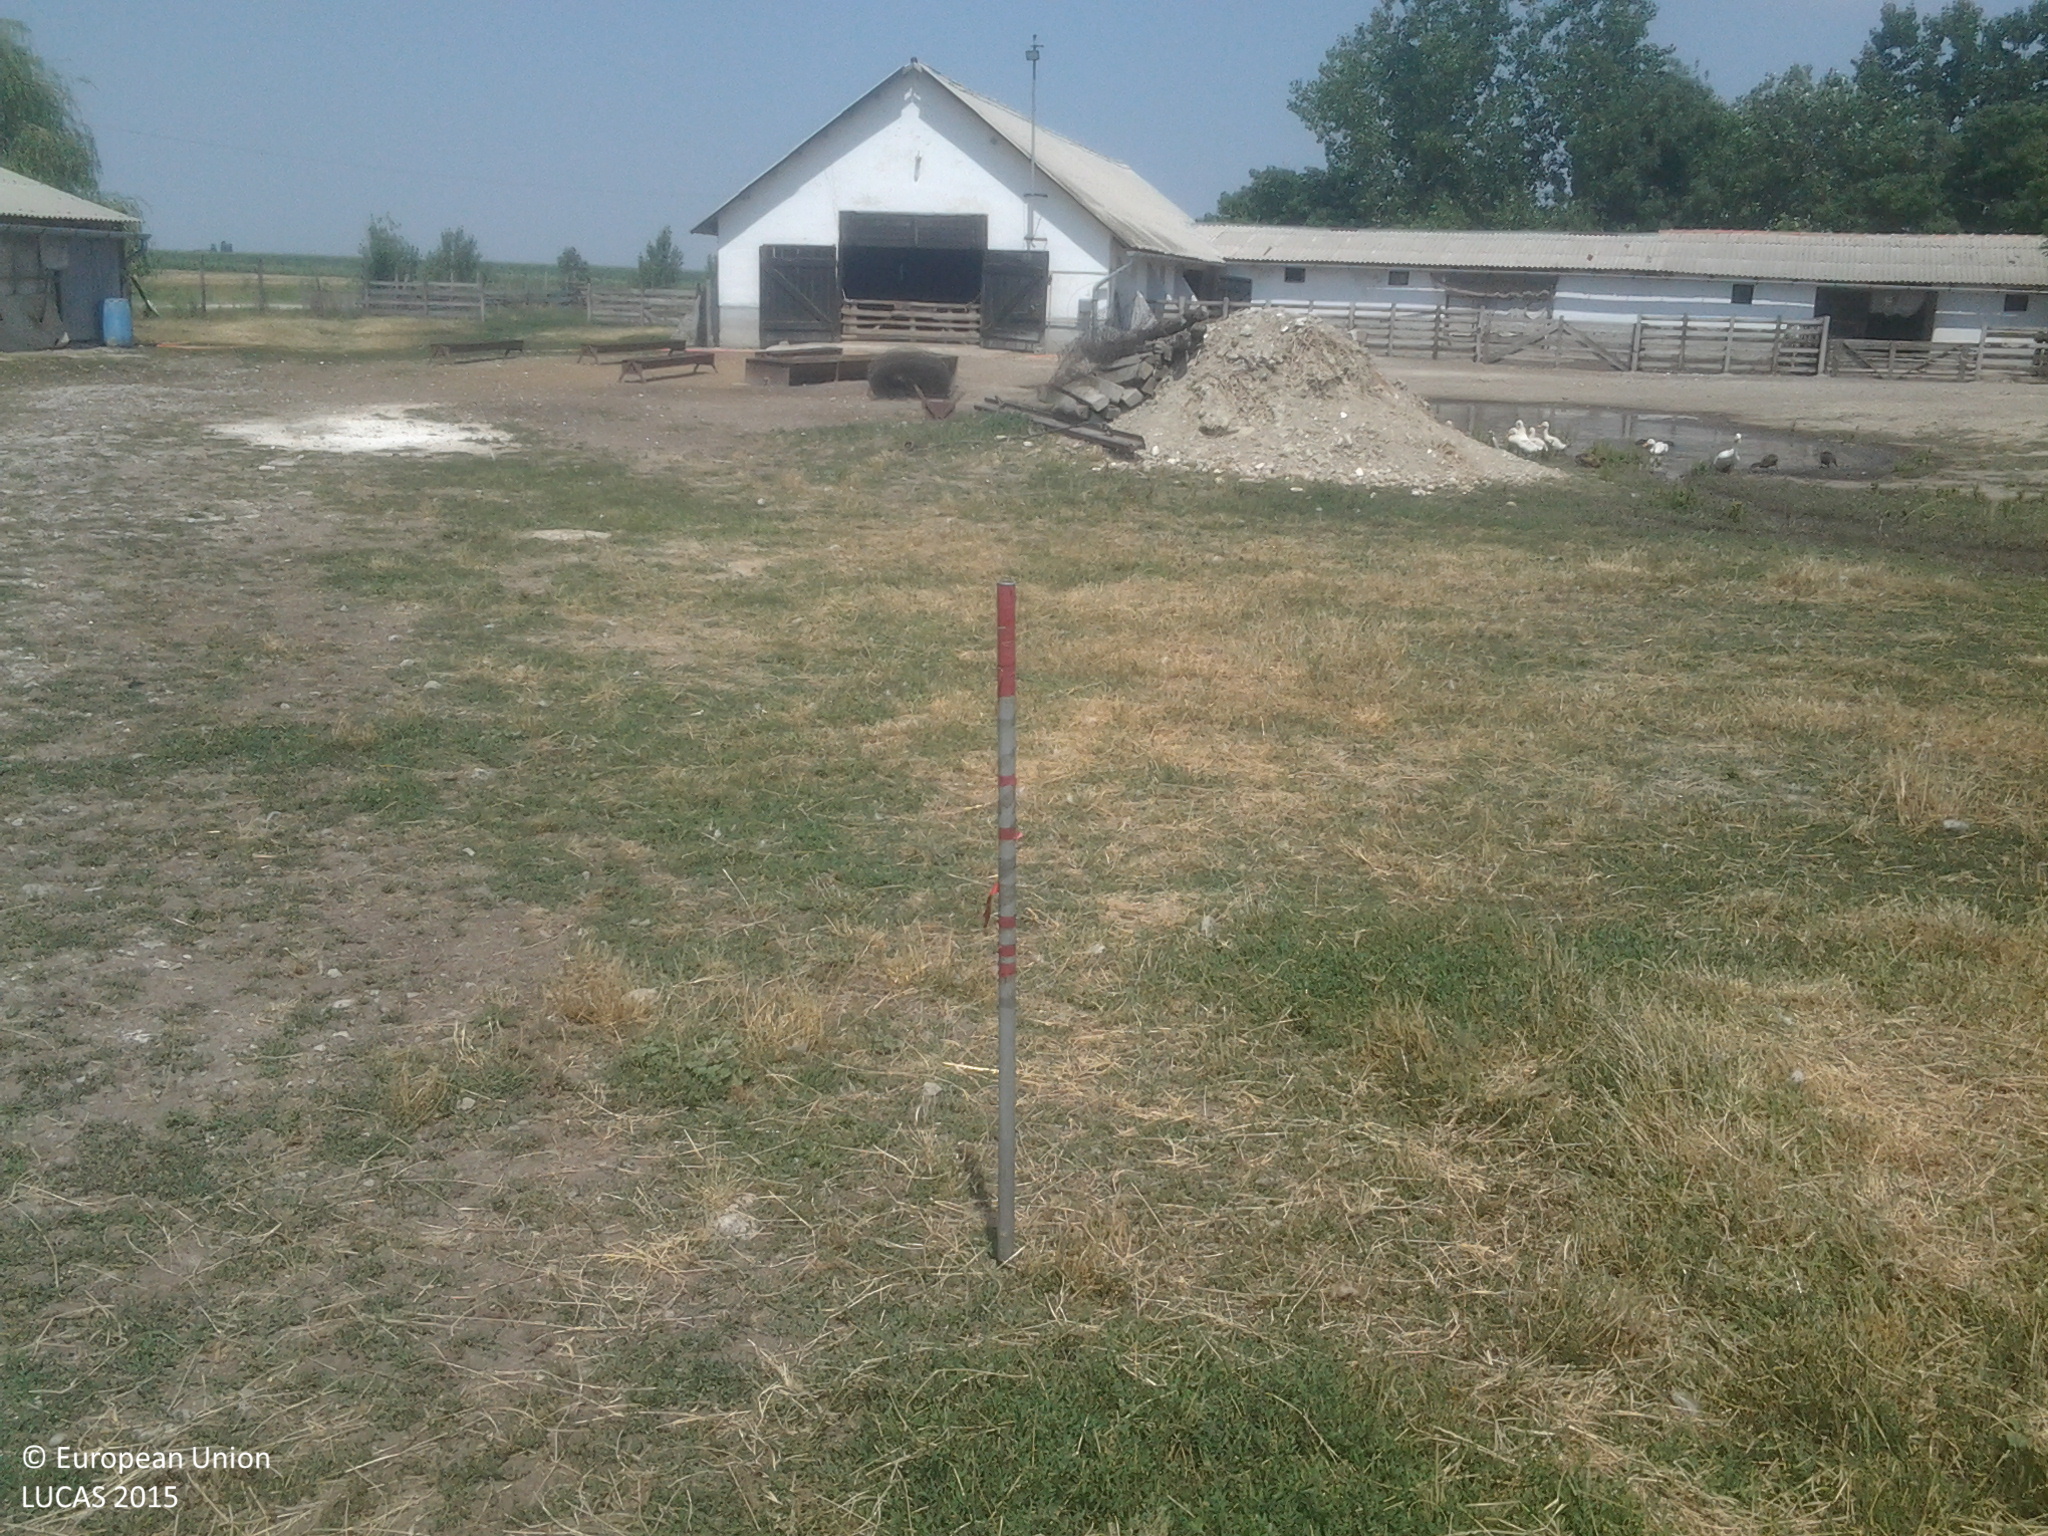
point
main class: Grassland
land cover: Grassland without tree/shrub cover
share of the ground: > 75 %
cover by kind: herbaceous plants 100 %
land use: Residential
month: July
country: HU
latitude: 47.0464
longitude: 19.1384
